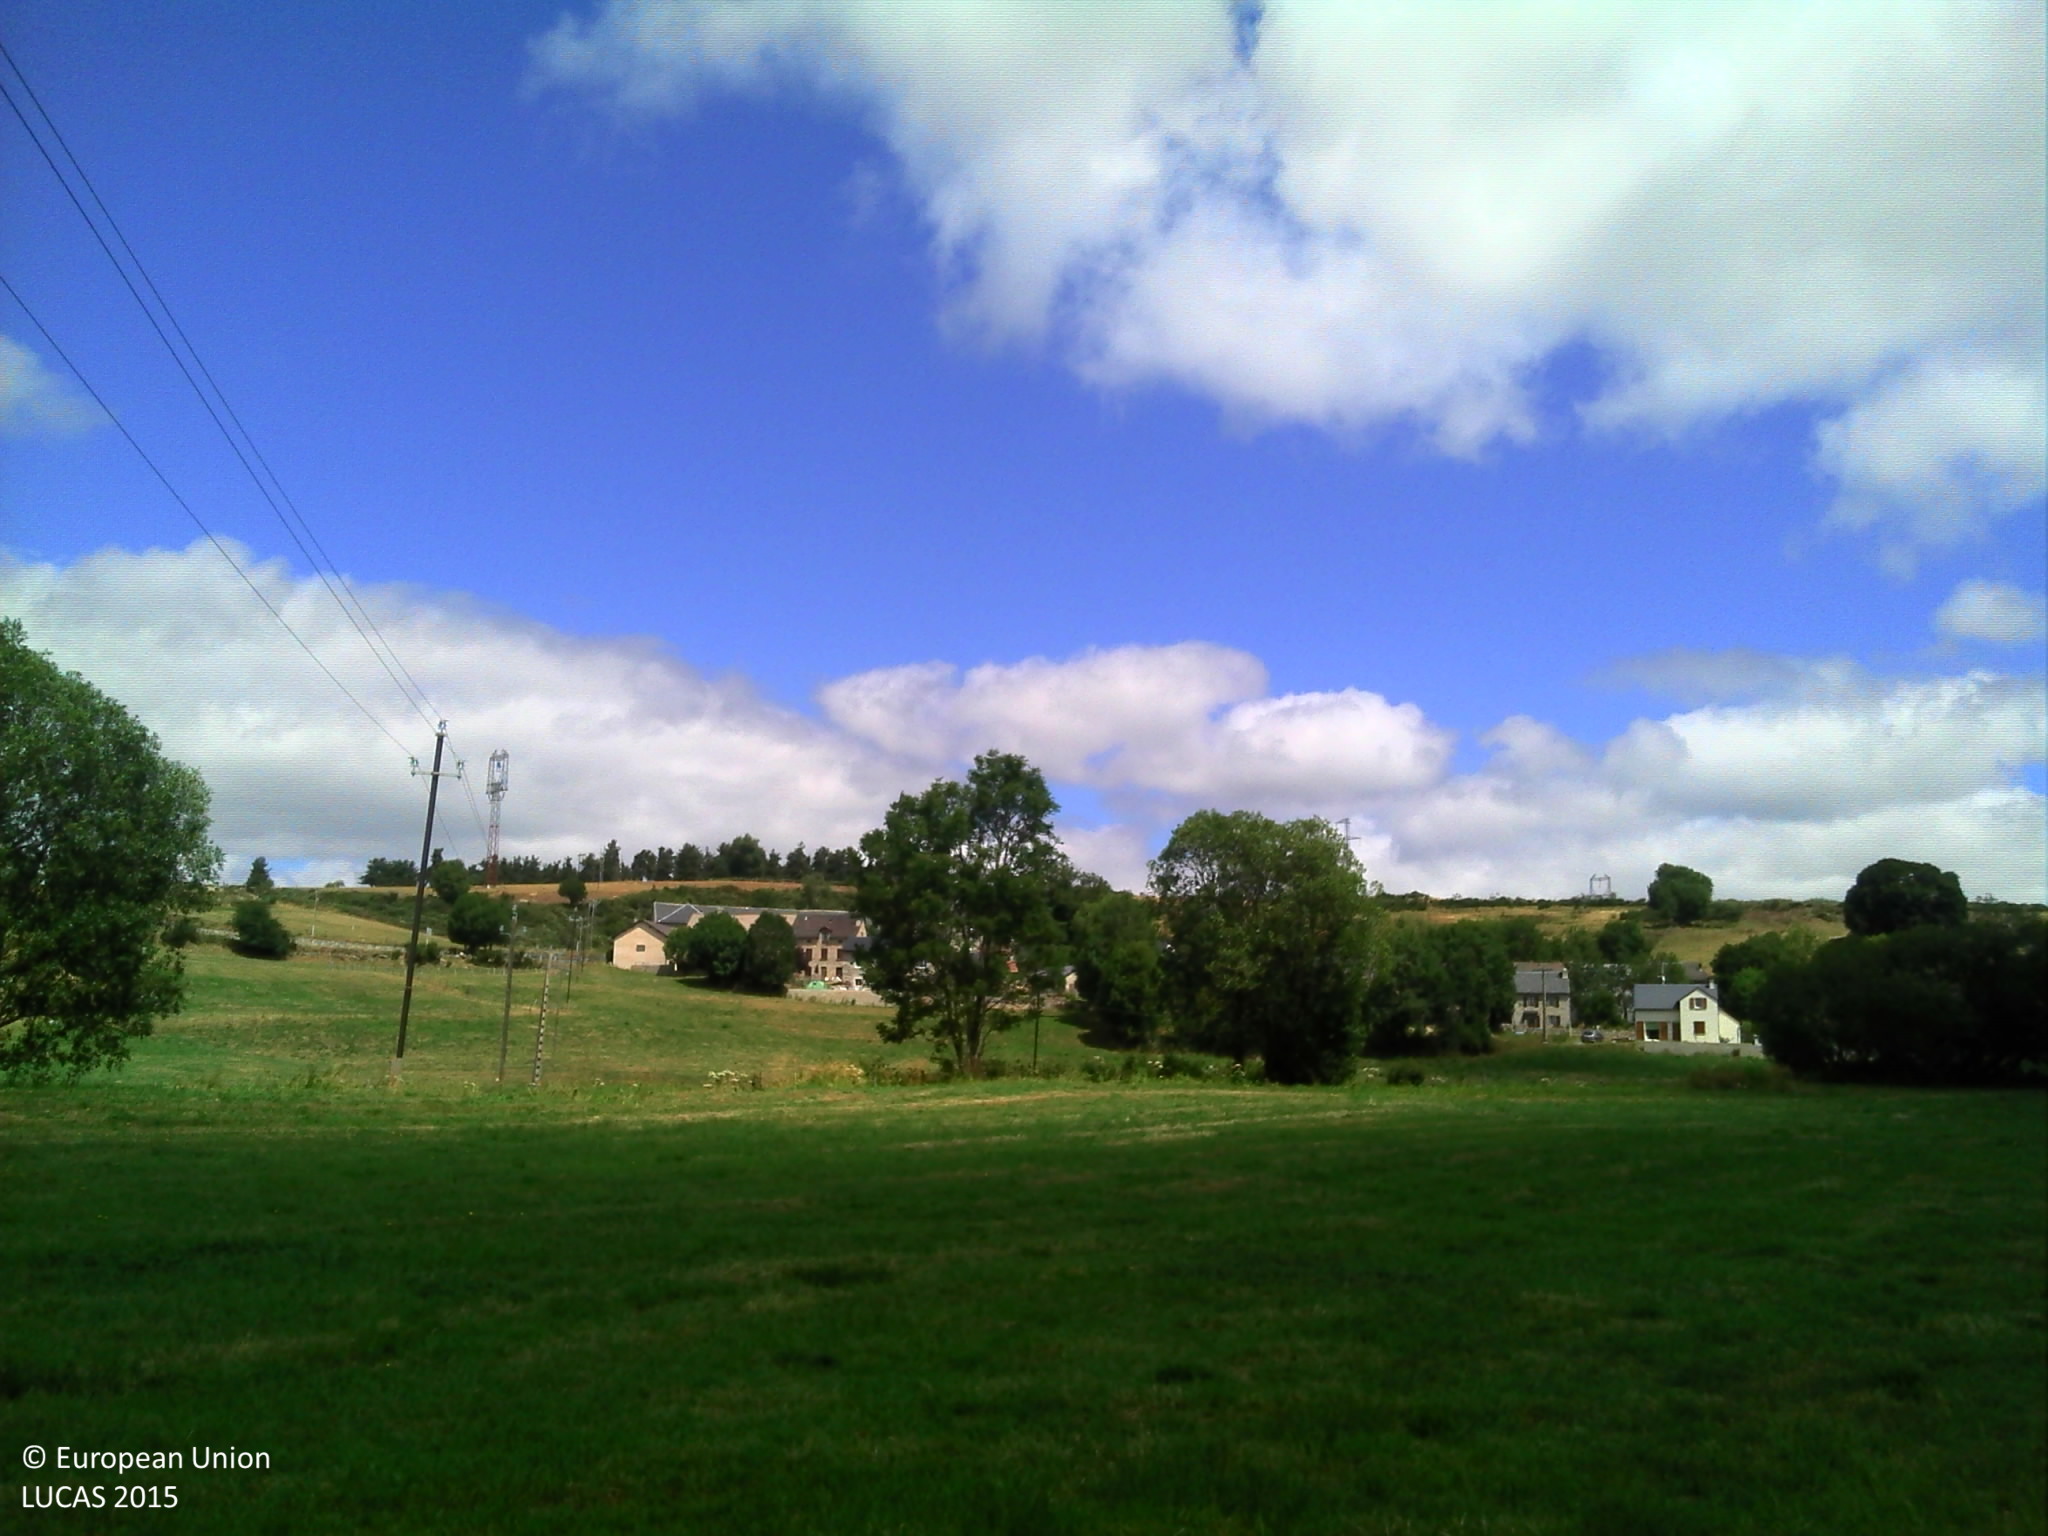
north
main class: Grassland
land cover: Grassland without tree/shrub cover
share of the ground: > 75 %
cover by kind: herbaceous plants 100 %
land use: Agriculture (excluding fallow land and kitchen gardens)
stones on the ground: 10 - 25 %
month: July
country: FR
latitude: 44.8122
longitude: 3.4414
